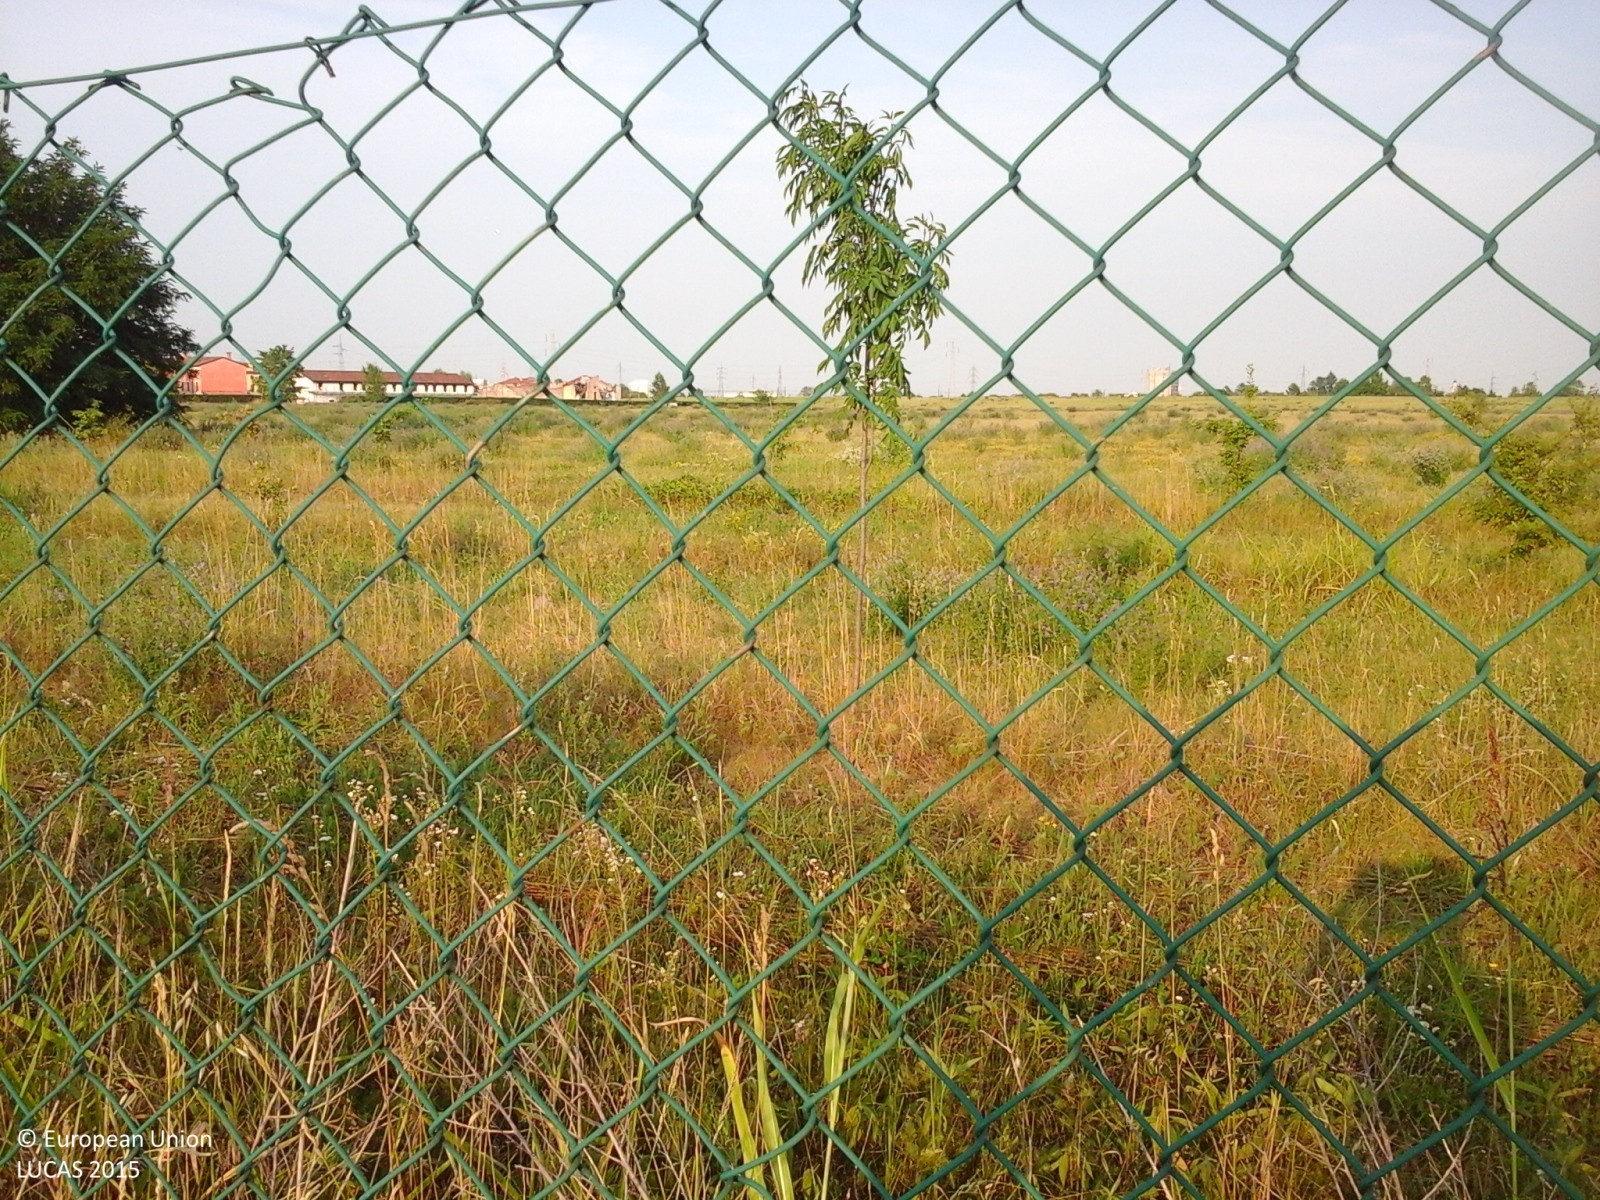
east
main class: Grassland
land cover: Grassland without tree/shrub cover
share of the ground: > 75 %
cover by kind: herbaceous plants 100 %
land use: Agriculture (excluding fallow land and kitchen gardens)
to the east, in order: Grassland without tree/shrub cover
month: July
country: IT
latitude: 45.3919
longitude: 10.9563
